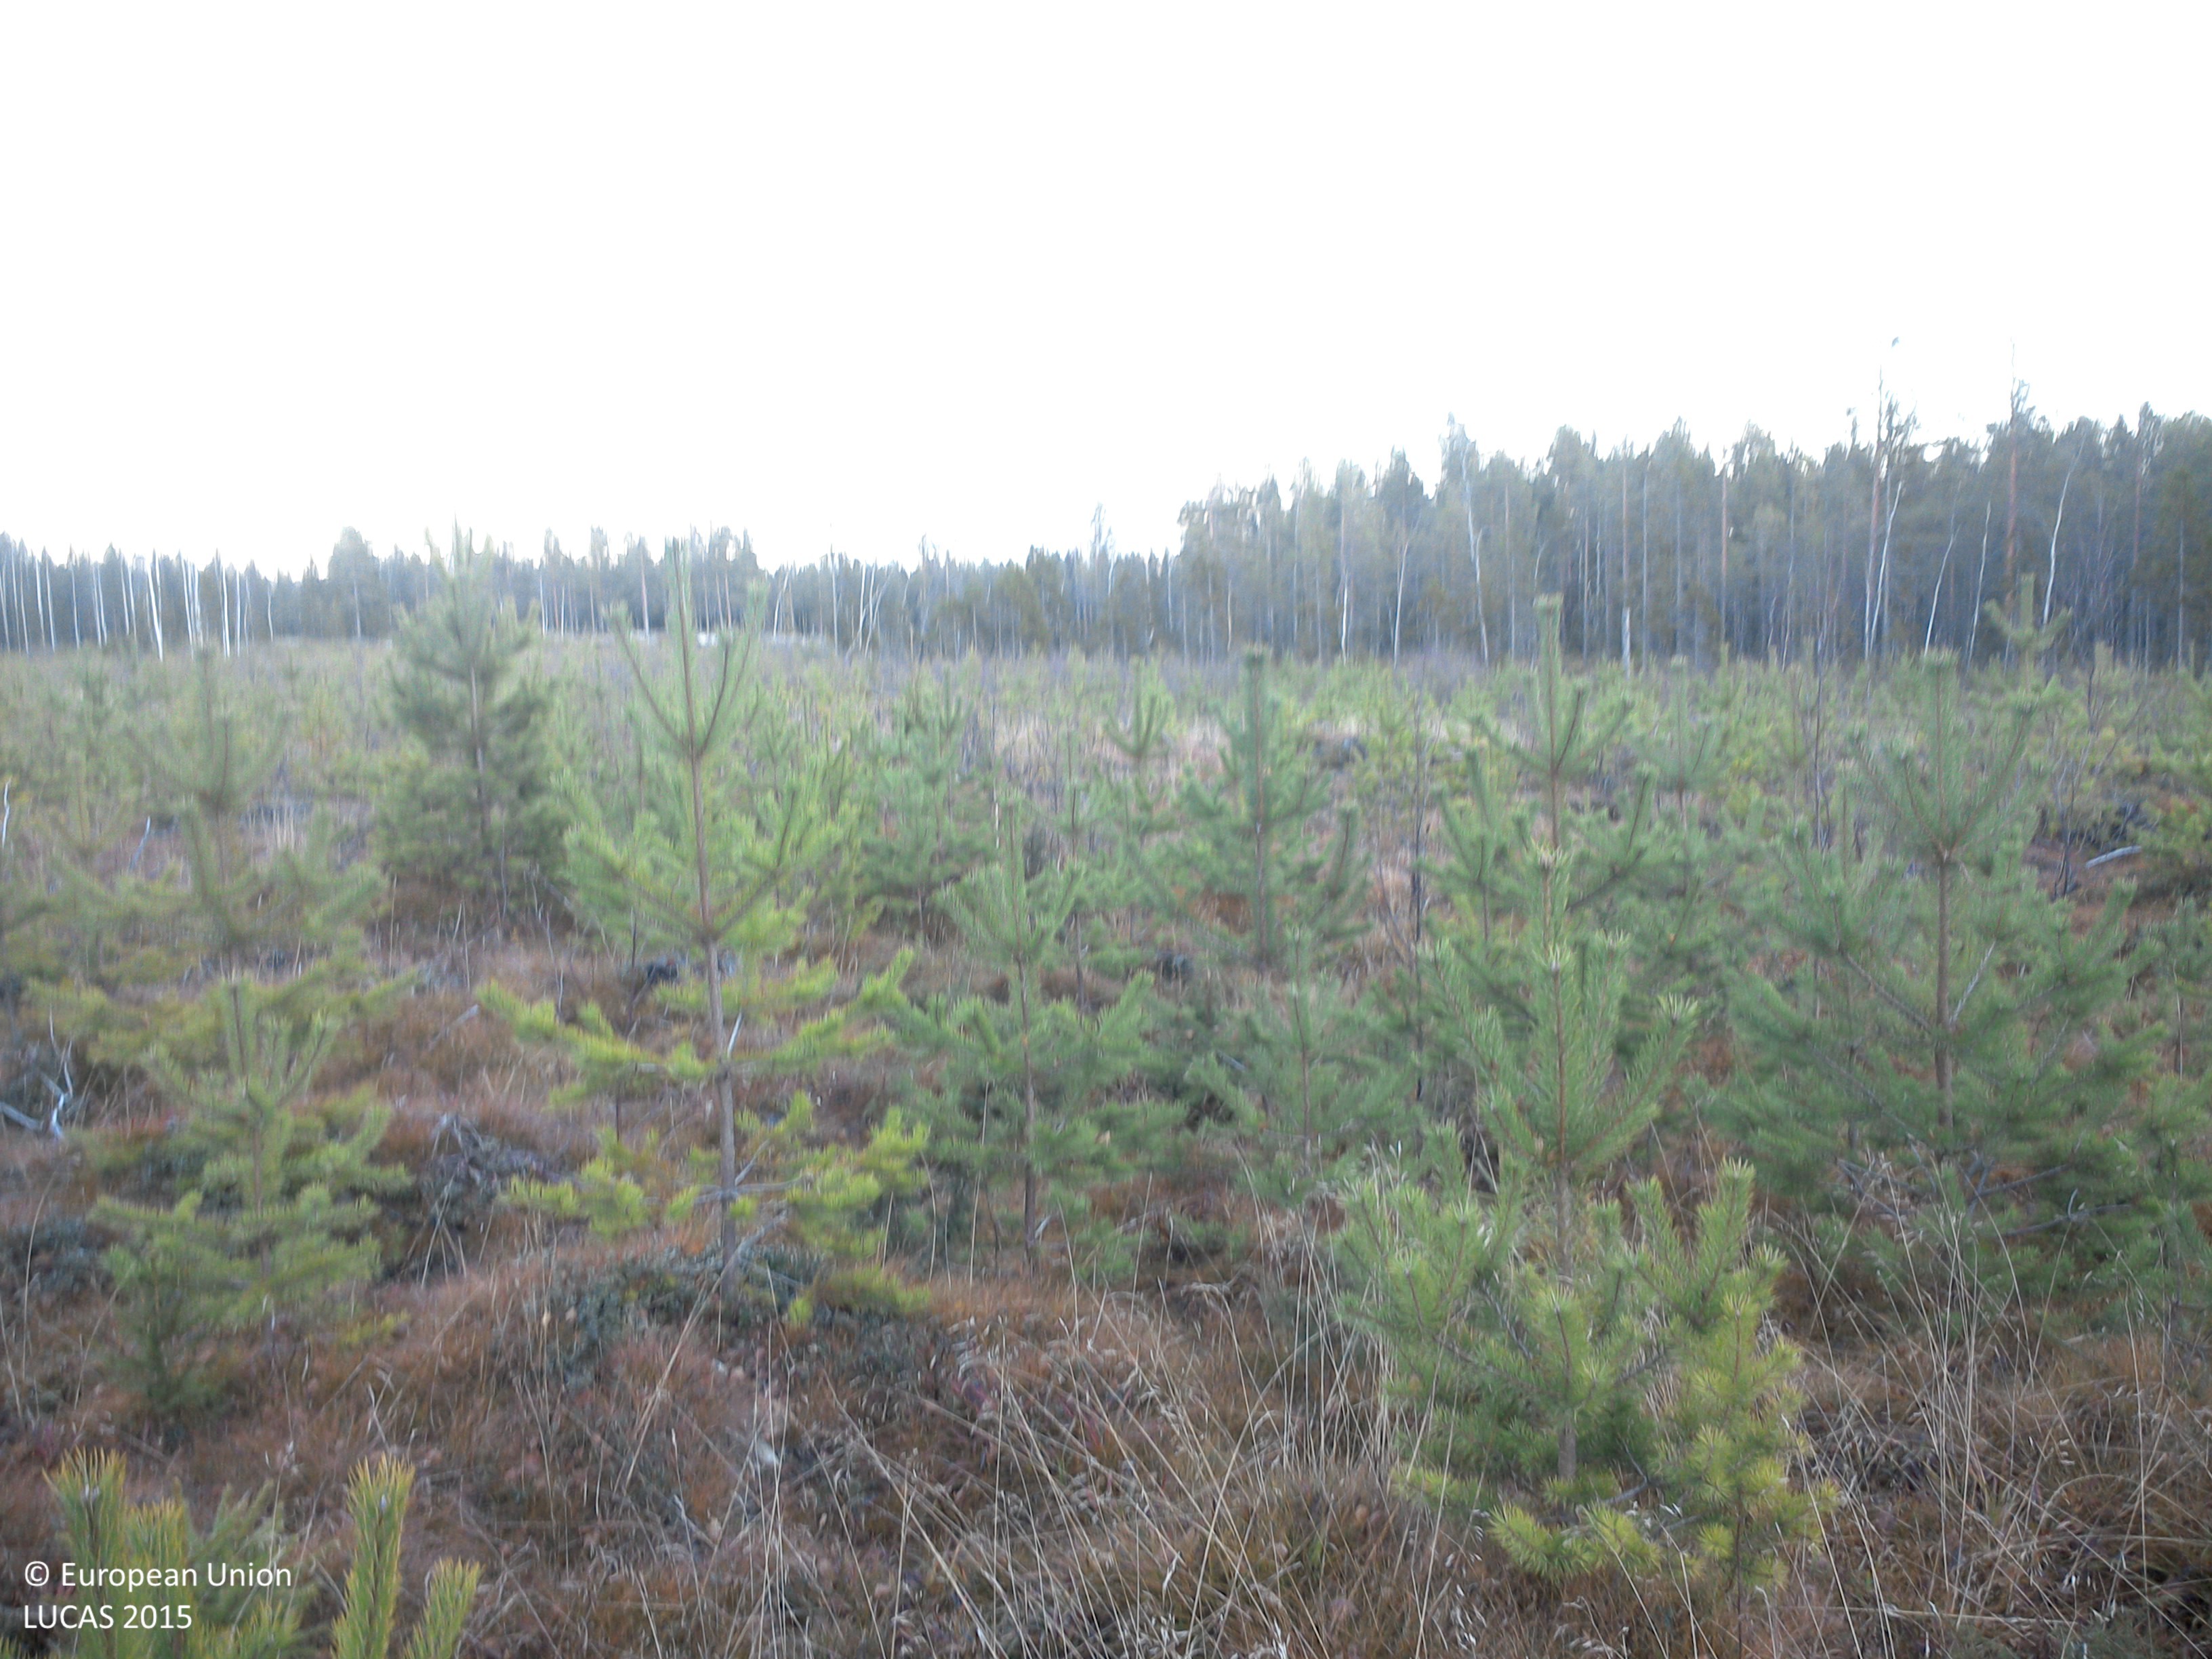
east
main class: Woodland
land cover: Pine dominated coniferous woodland
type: boreal forest
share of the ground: 25 - 50 %
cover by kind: shrubs 40 %, herbaceous plants 30 %, coniferous forest trees 25 %, broadleaved forest trees 5 %
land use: Forestry
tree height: < 5 m
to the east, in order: Pine dominated coniferous woodland; Pine dominated mixed woodland; Other coniferous woodland; Spruce dominated mixed woodland
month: November
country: SE
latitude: 63.7581
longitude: 19.9333
